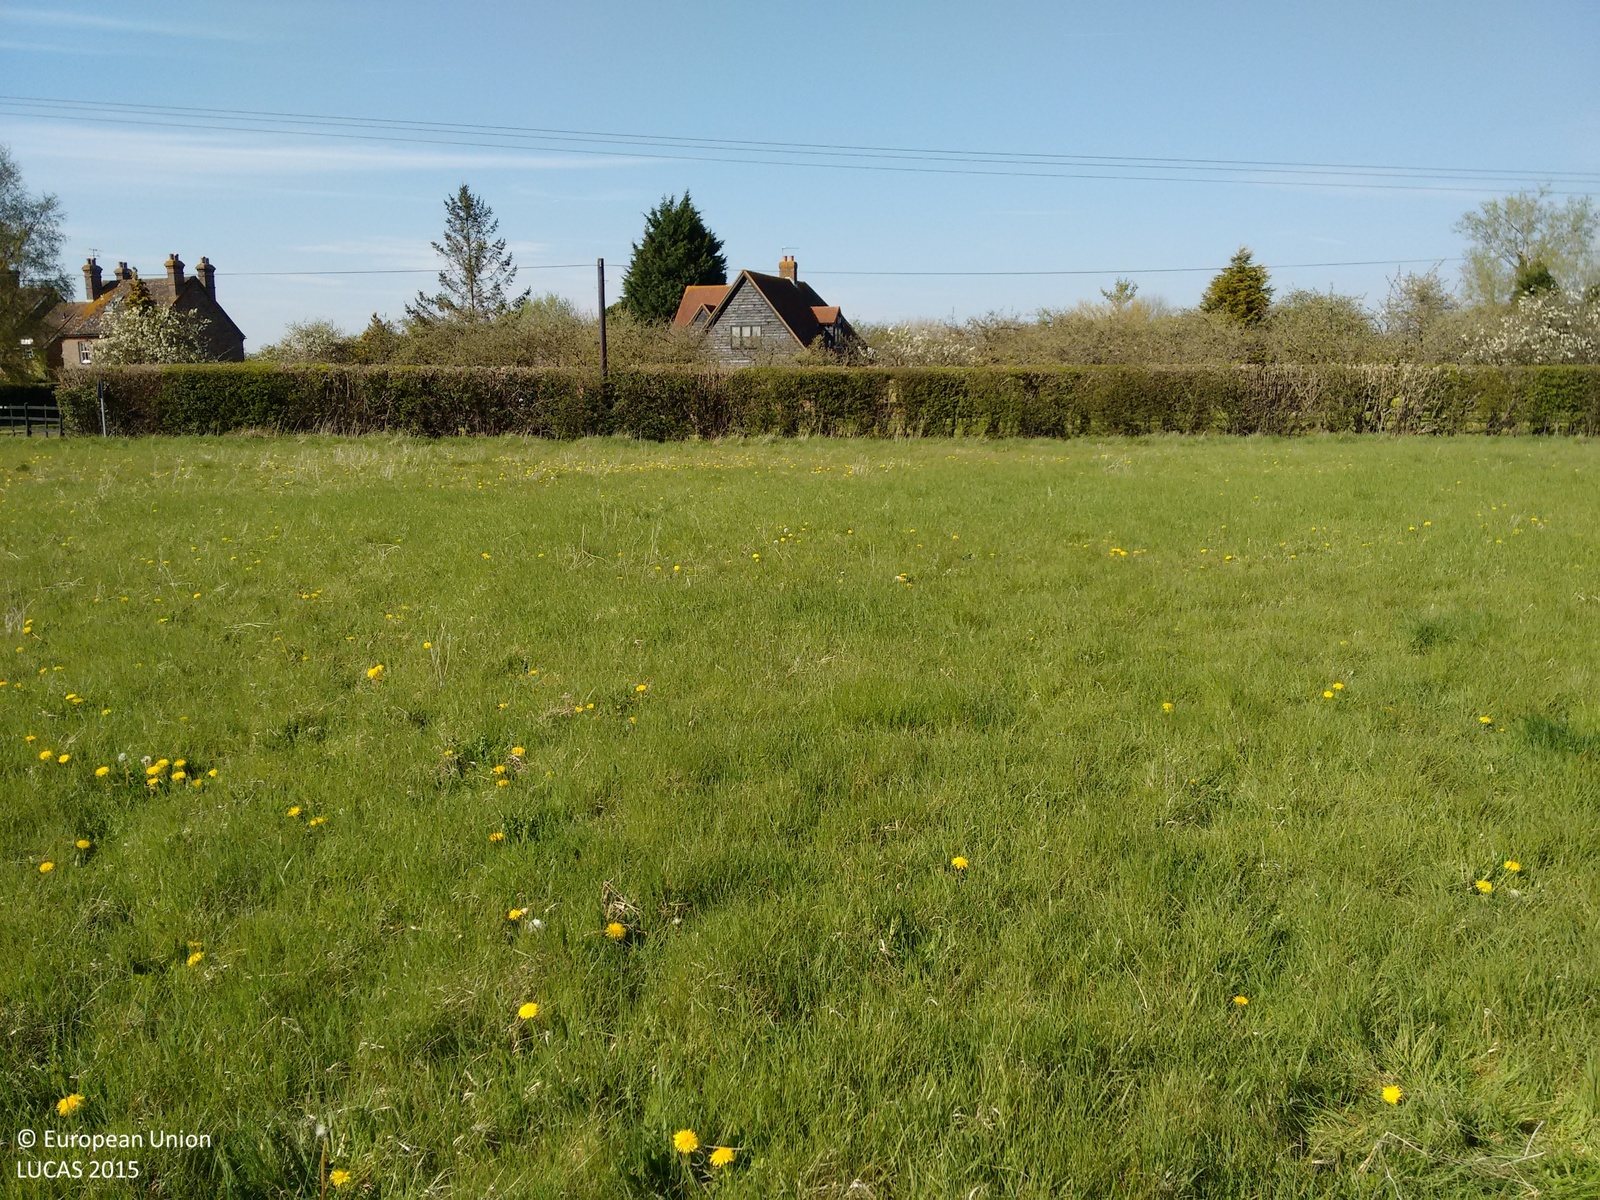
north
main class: Grassland
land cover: Grassland without tree/shrub cover
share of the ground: > 75 %
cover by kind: herbaceous plants 100 %
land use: Agriculture (excluding fallow land and kitchen gardens)
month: April
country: GB
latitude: 51.2062
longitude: 0.3666
